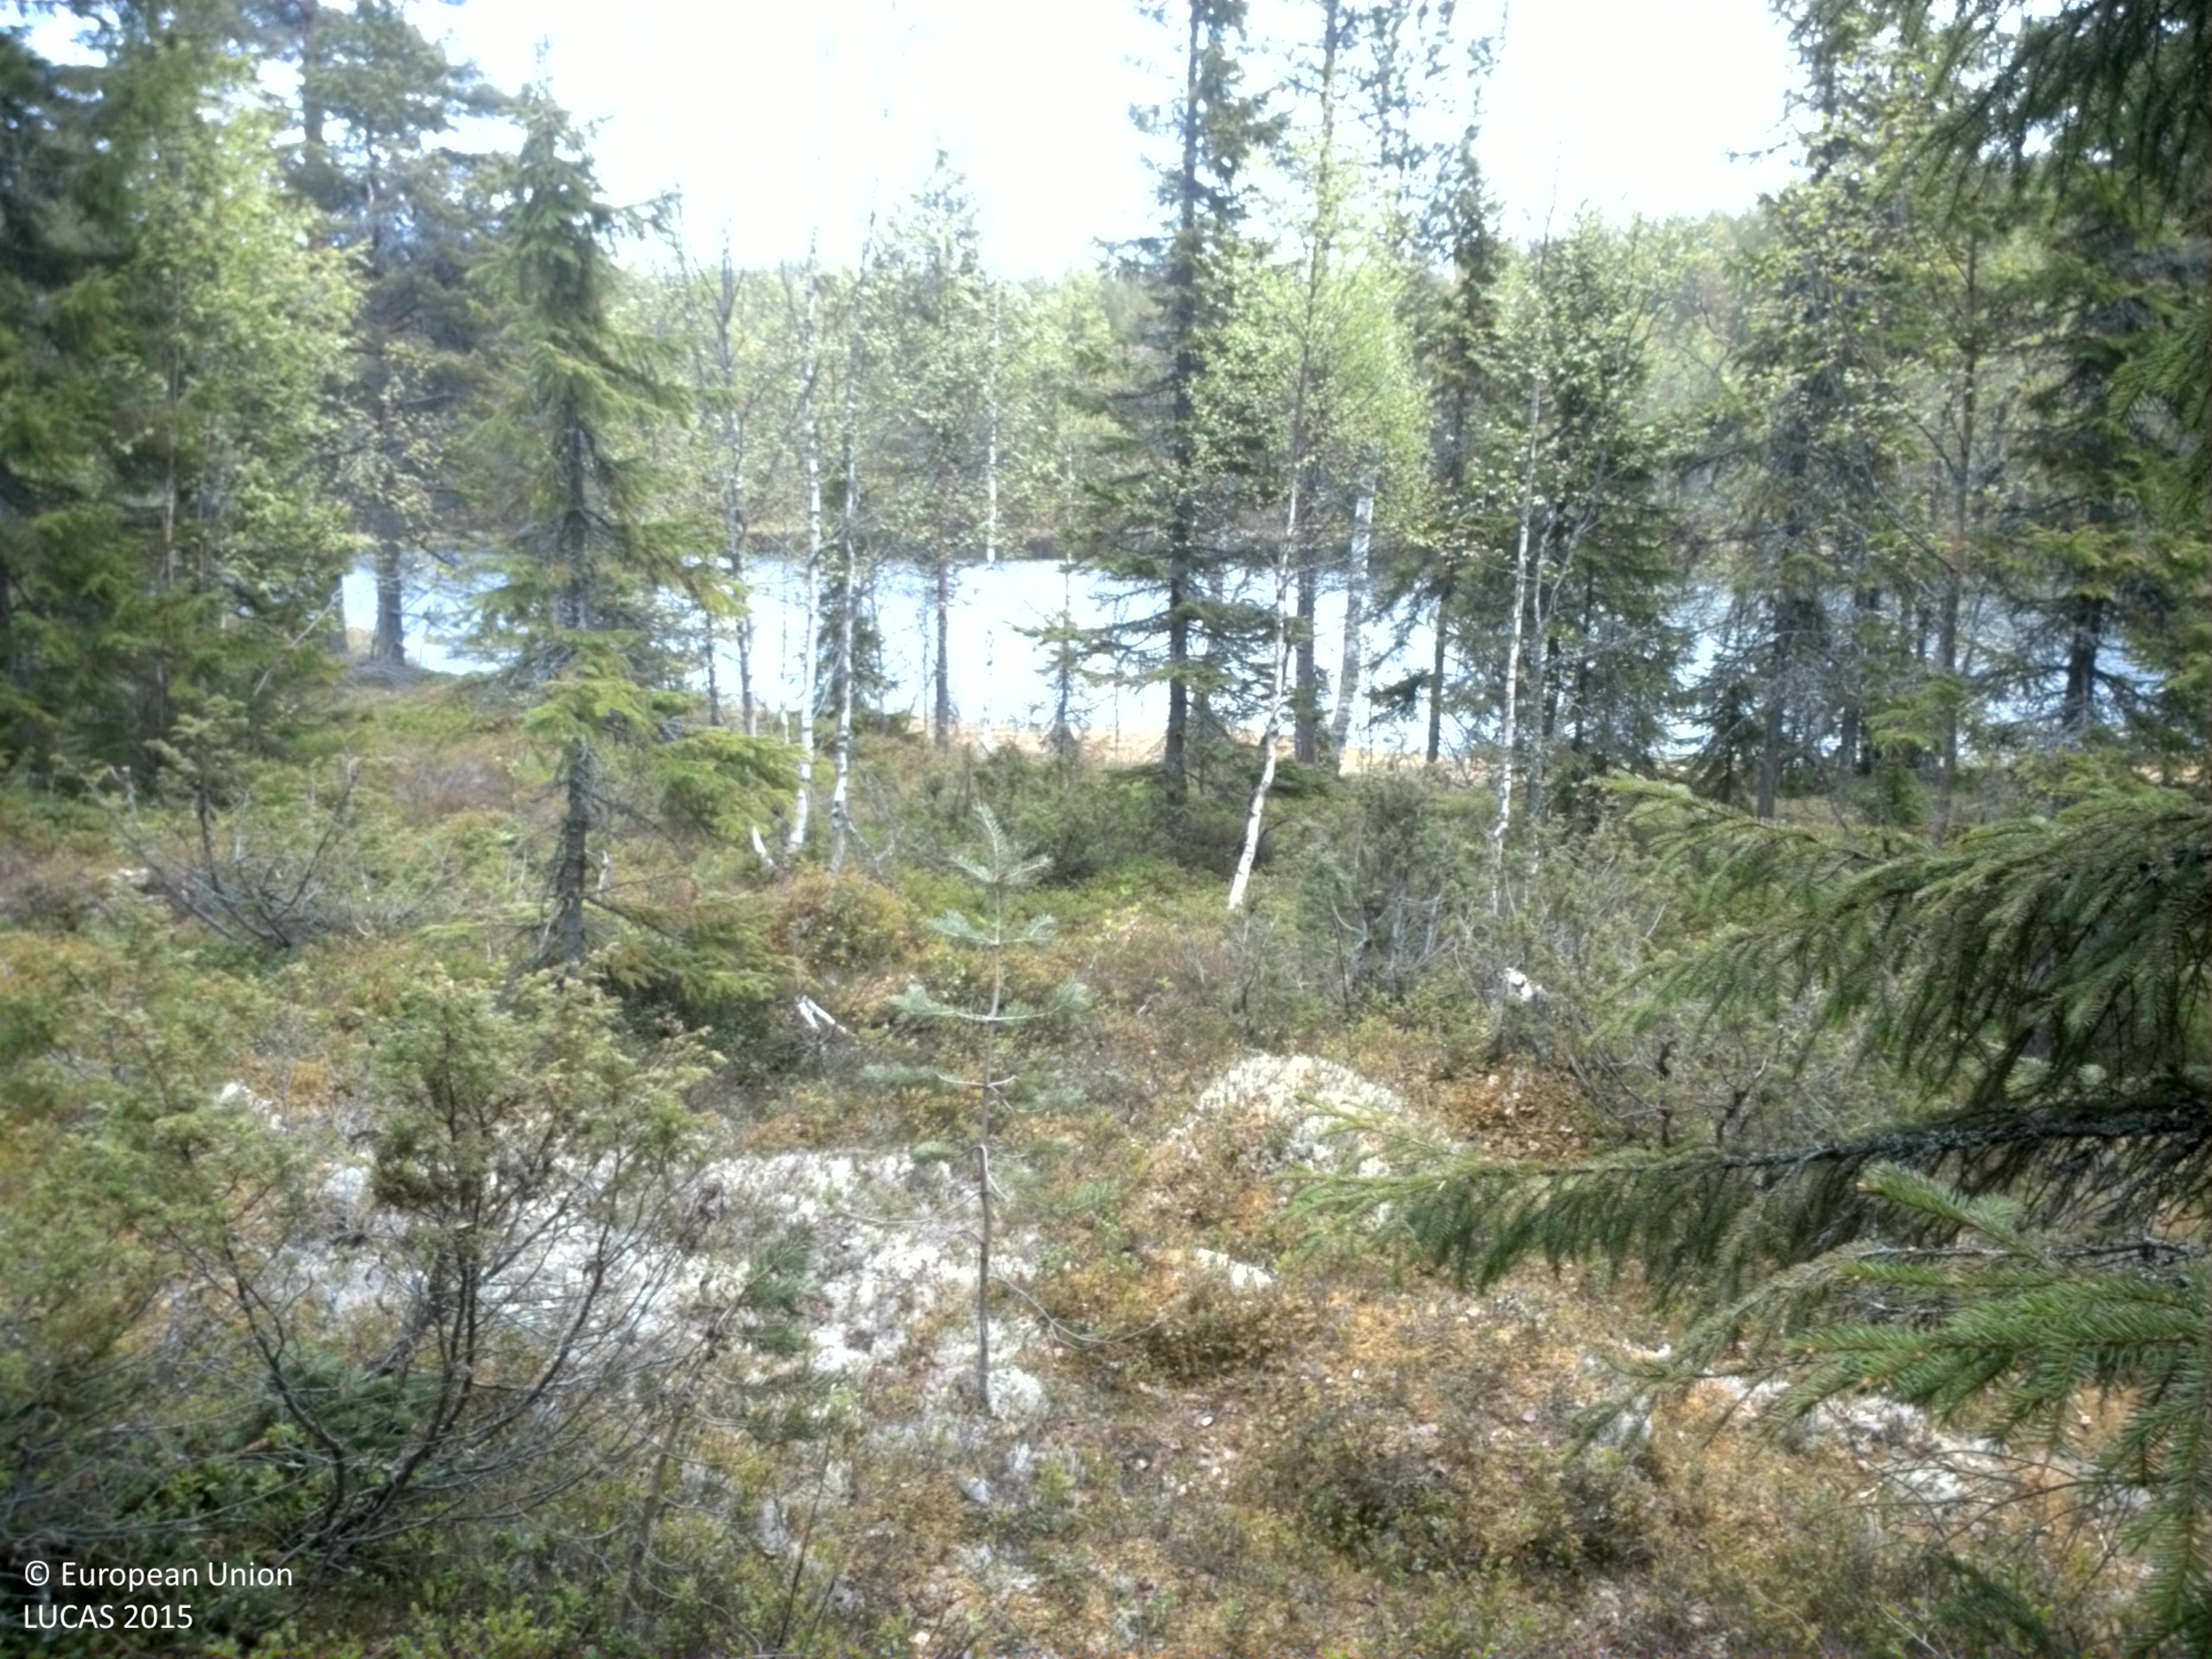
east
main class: Woodland
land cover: Spruce dominated mixed woodland
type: boreal forest
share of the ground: > 75 %
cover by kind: coniferous forest trees 60 %, broadleaved forest trees 20 %, shrubs 10 %, lichens and mosses 10 %
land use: Forestry
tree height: > 5 m
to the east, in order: Spruce dominated mixed woodland; Peatbogs; Inland fresh water bodies; Other mixed woodland; Pine dominated coniferous woodland; Pine dominated mixed woodland
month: June
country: SE
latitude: 62.9432
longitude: 17.2879
